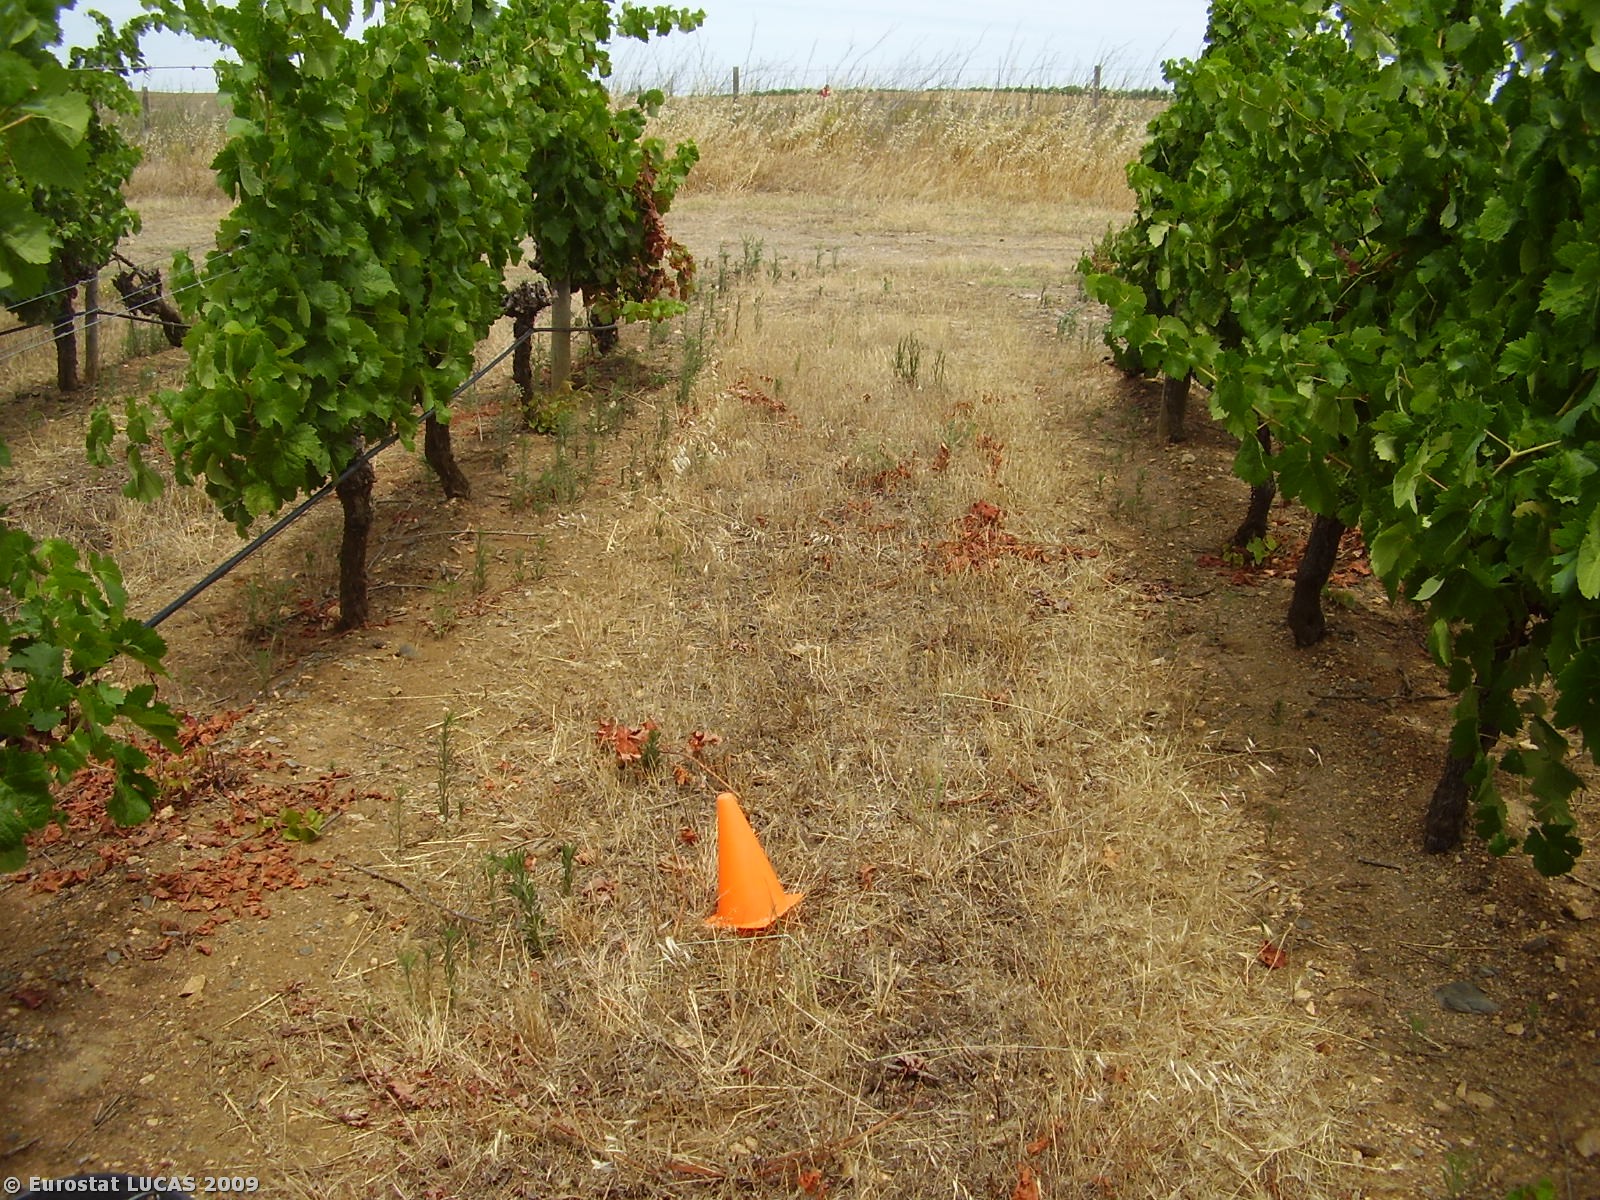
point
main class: Cropland
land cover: Vineyards
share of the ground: 10 - 25 %
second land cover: Spontaneously vegetated surfaces
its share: 50 - 75 %
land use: Agriculture (excluding fallow land and kitchen gardens)
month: July
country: PT
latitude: 38.5581
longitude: -7.8597
